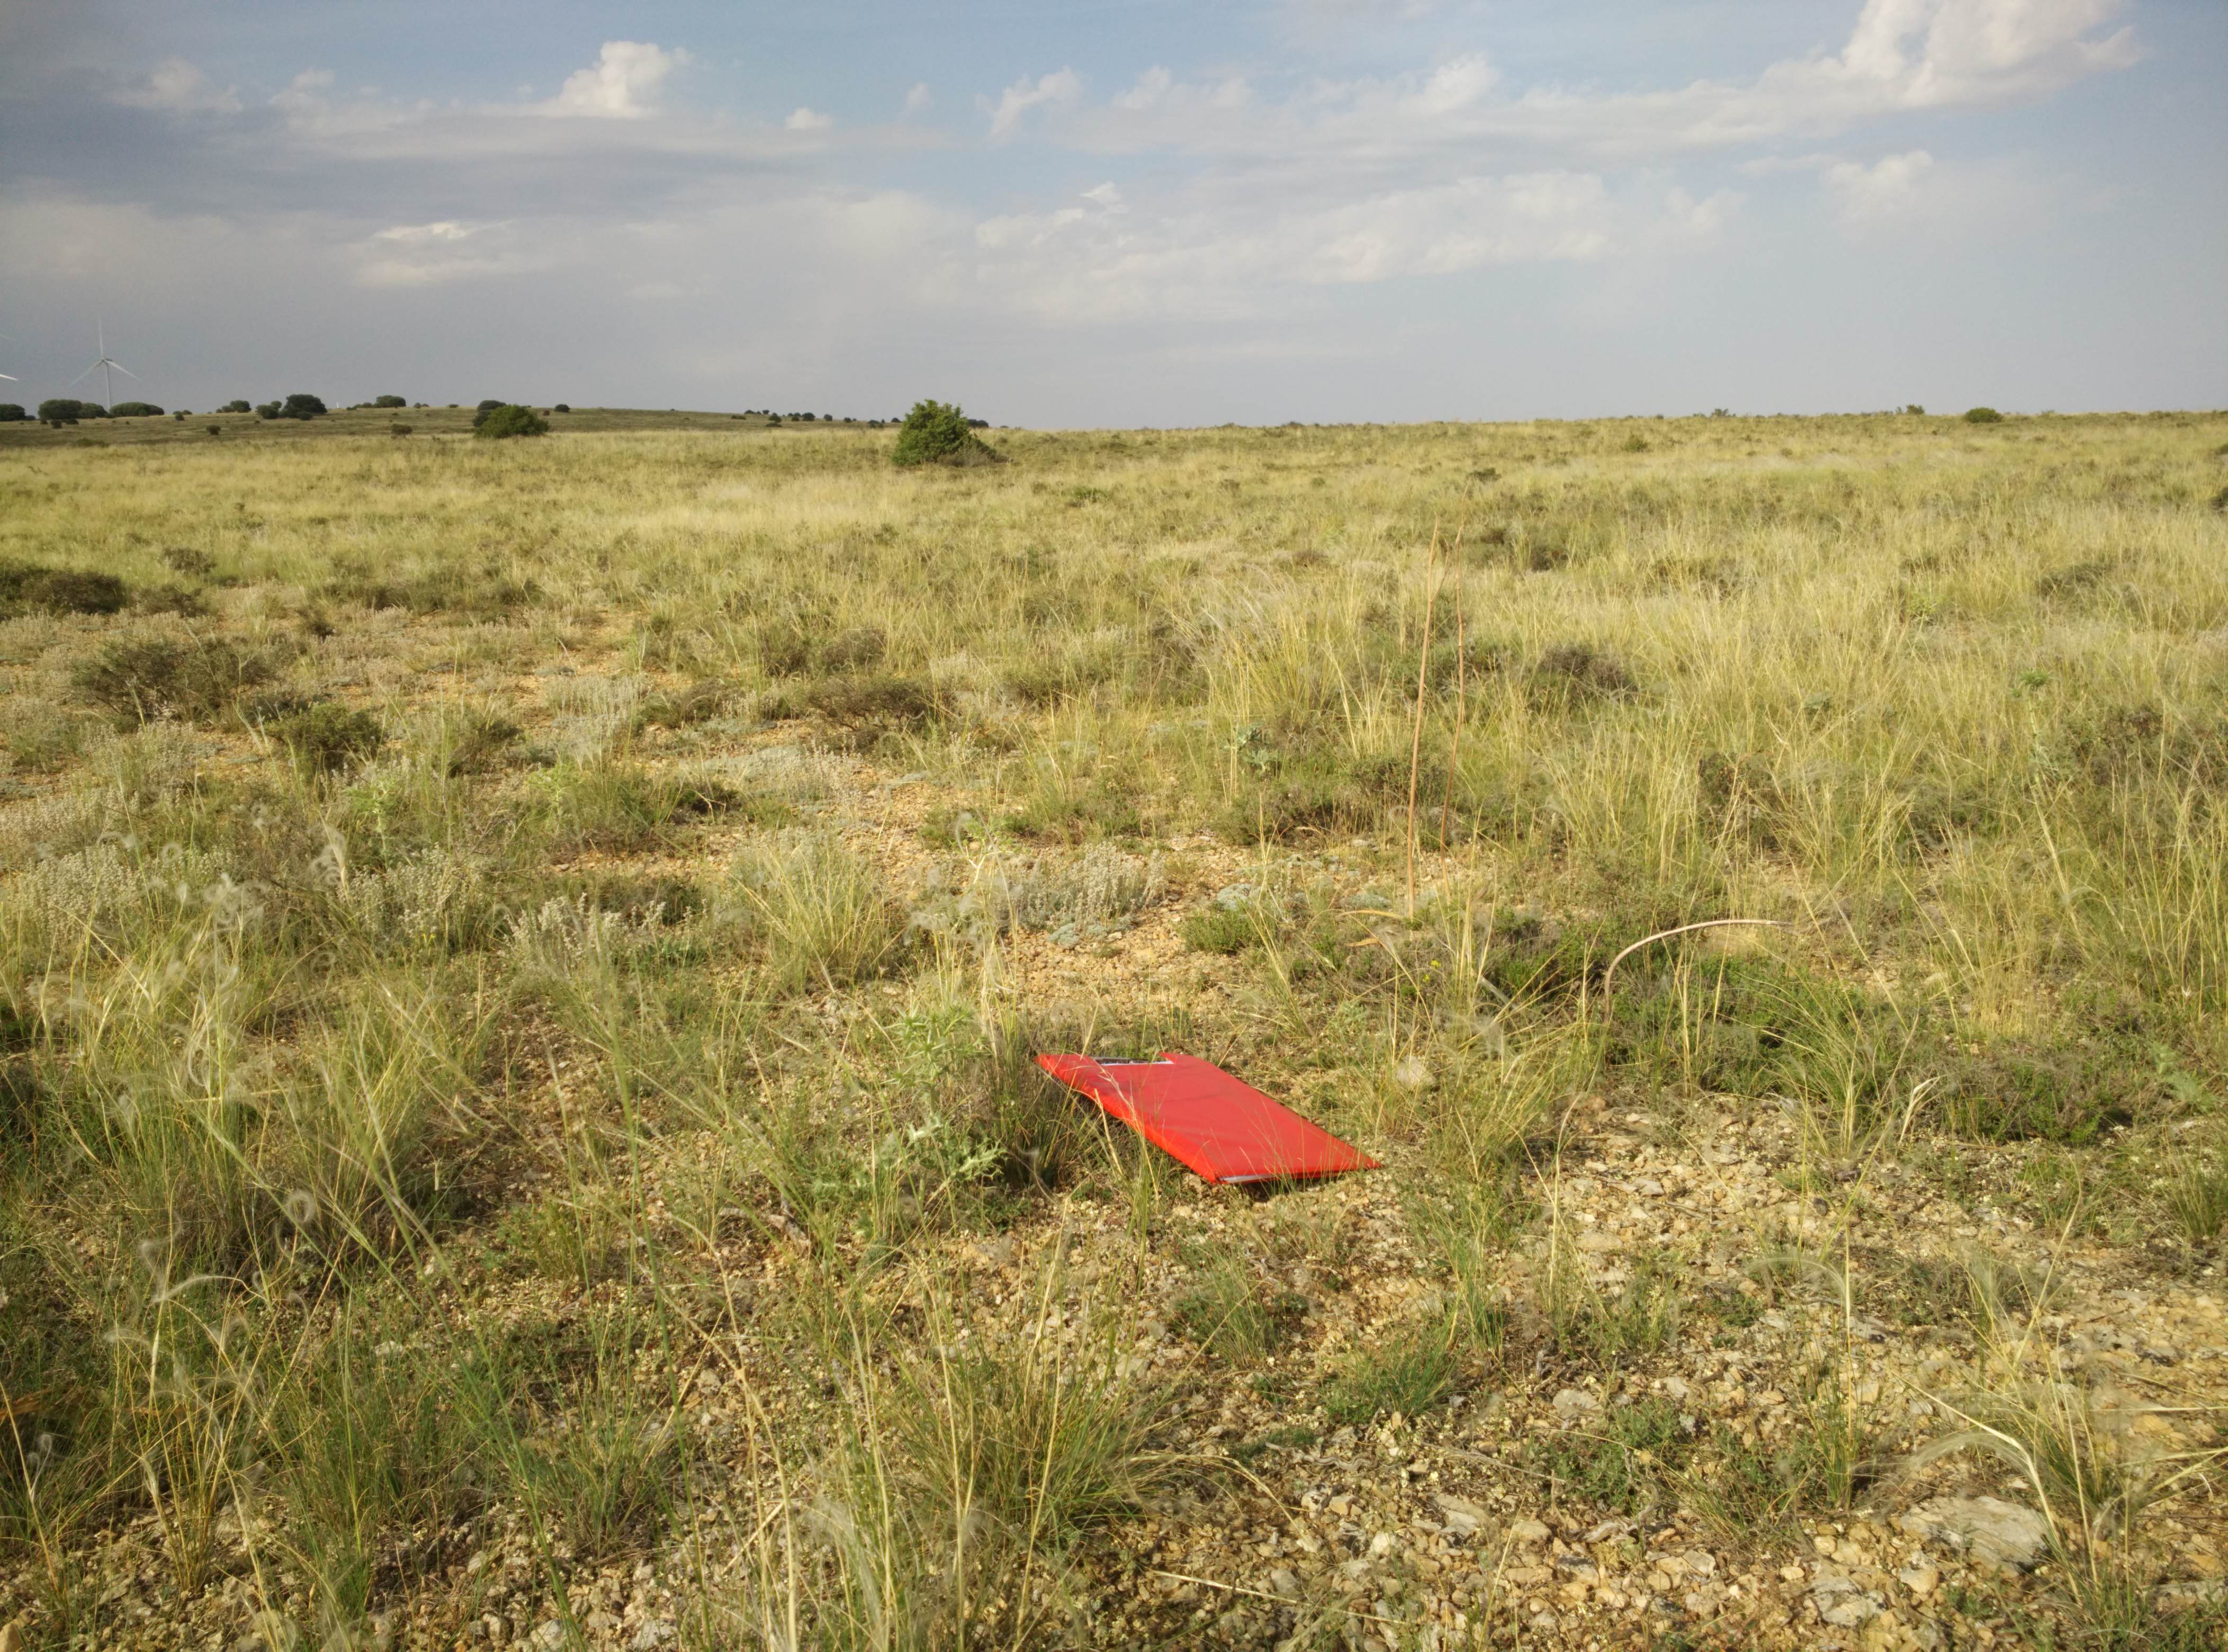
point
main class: Shrubland
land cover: Shrubland without tree cover
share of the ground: 50 - 75 %
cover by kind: shrubs 50 %, unconsolidated bare surface 45 %, herbaceous plants 5 %
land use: Agriculture (excluding fallow land and kitchen gardens)
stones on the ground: 25 - 50 %
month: July
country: ES
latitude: 40.9861
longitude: -1.8739
